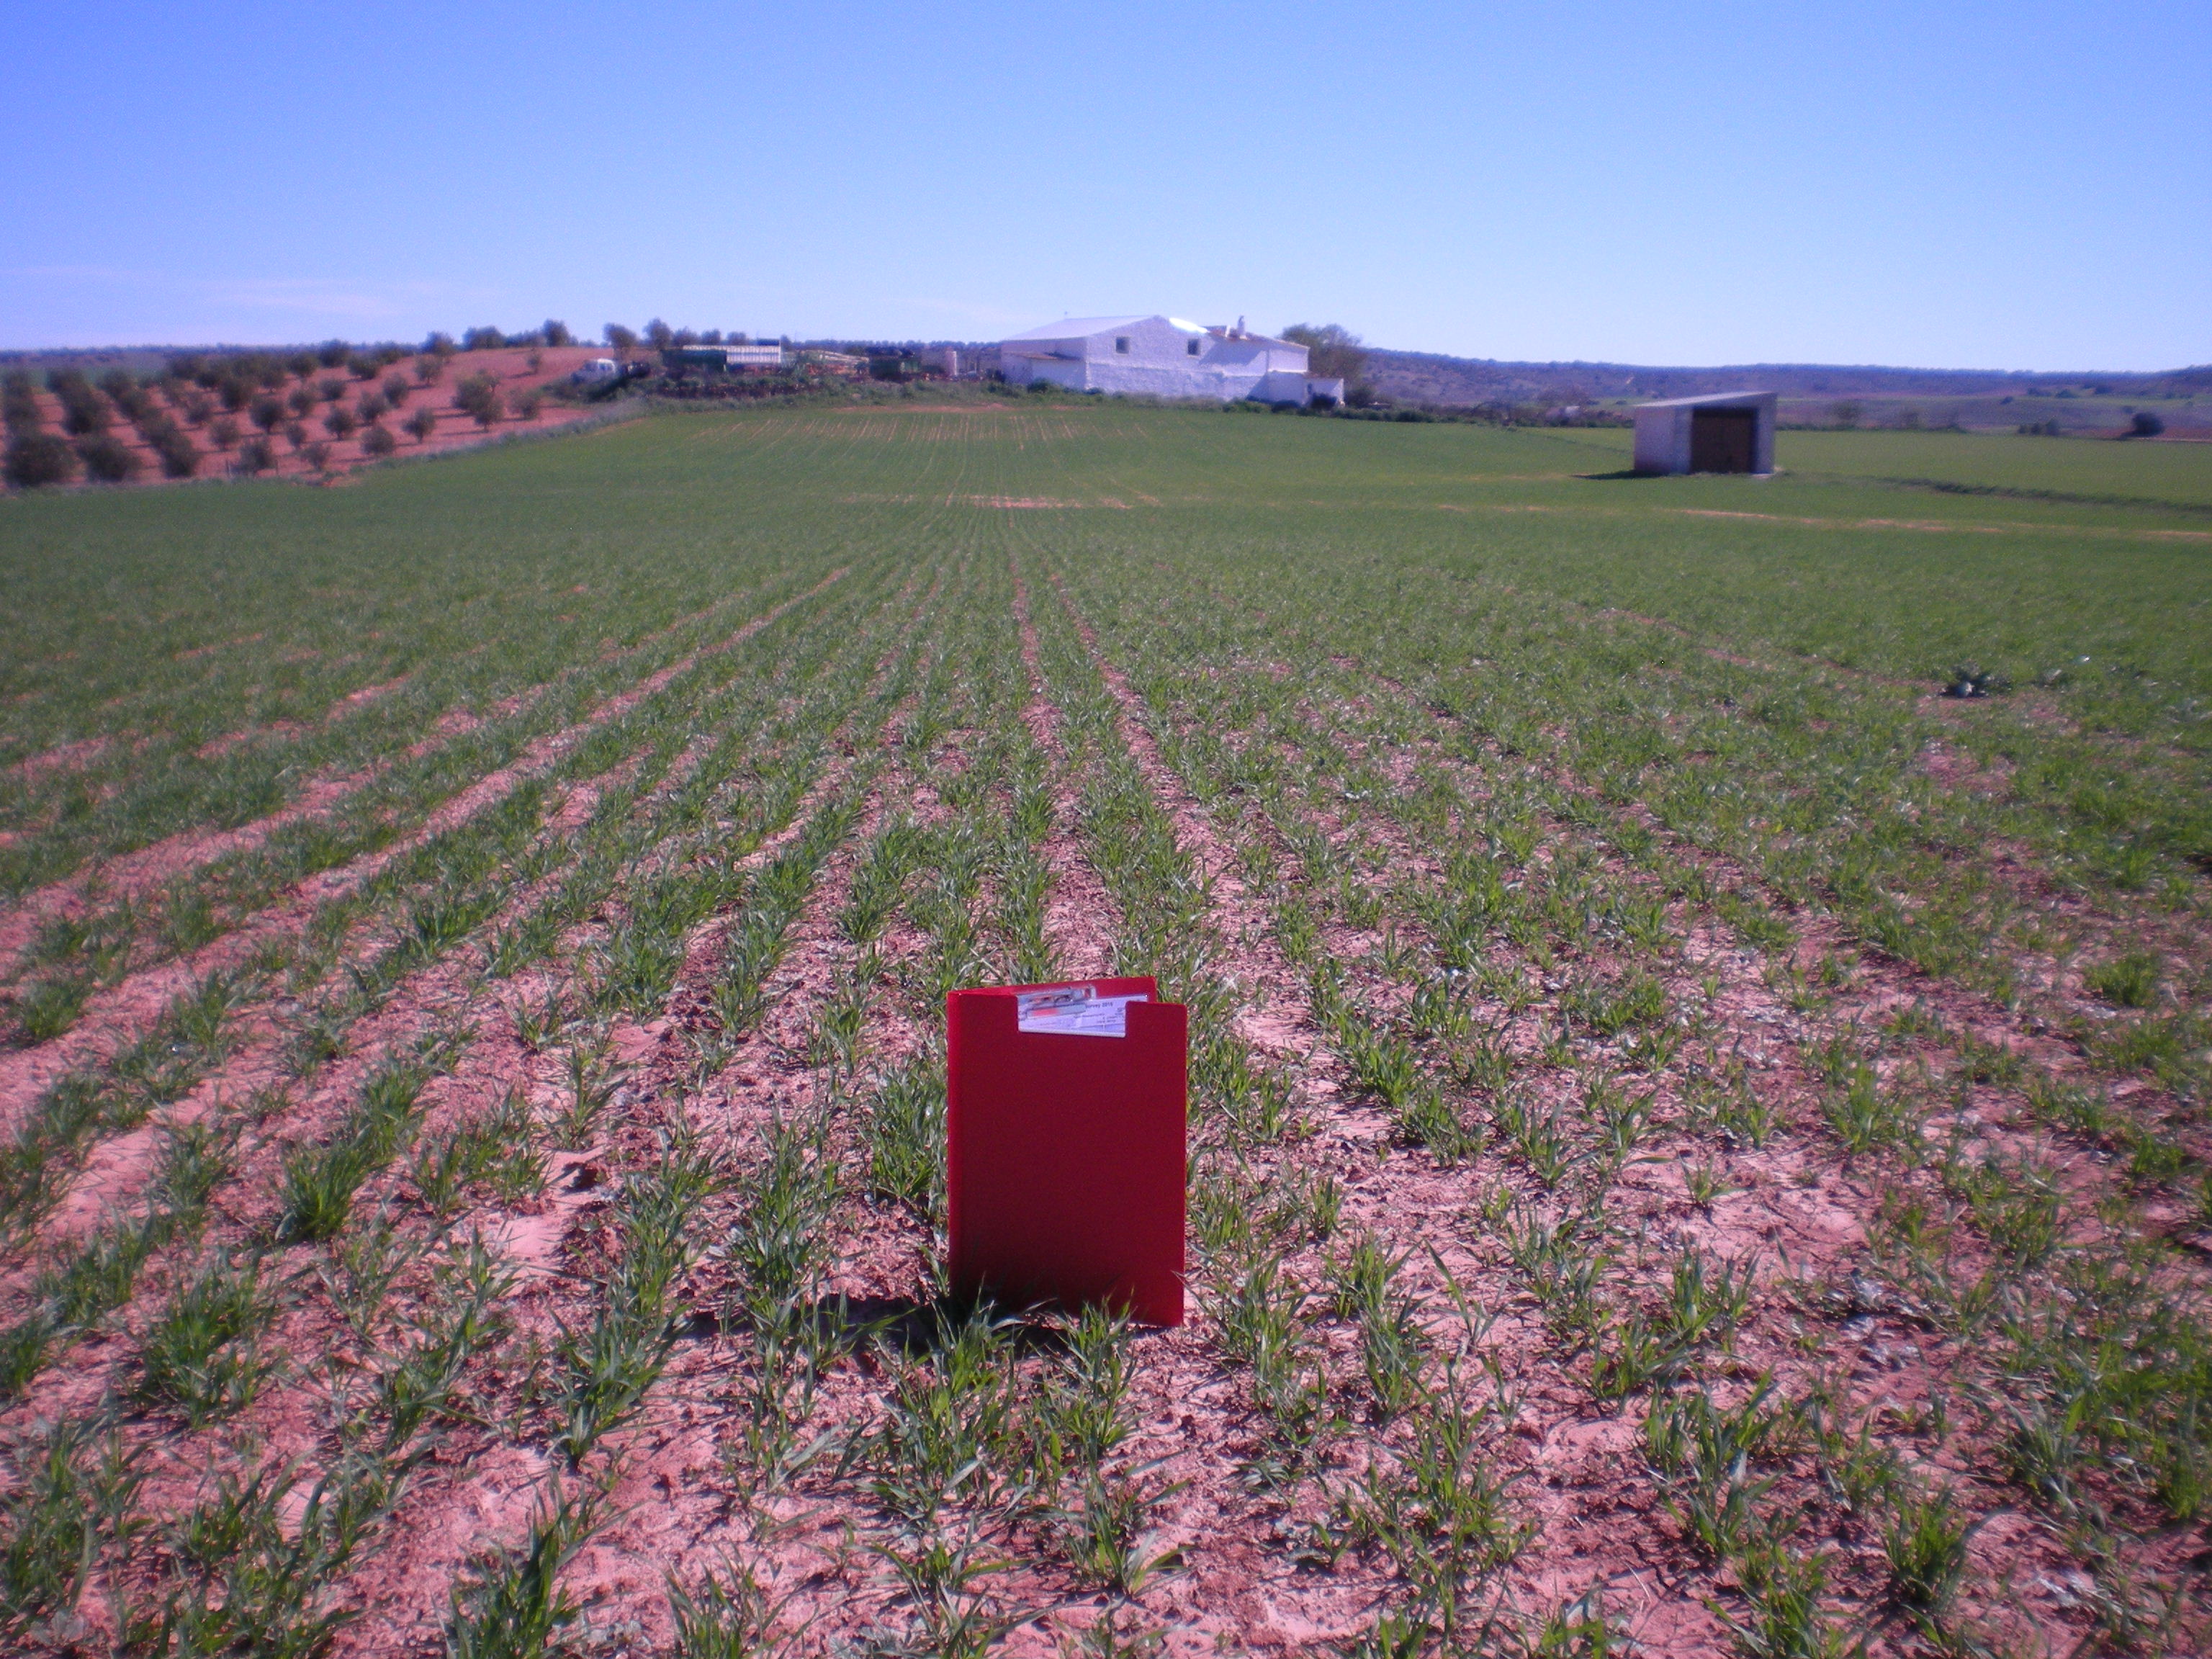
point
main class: Cropland
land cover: Barley
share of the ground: 25 - 50 %
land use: Agriculture (excluding fallow land and kitchen gardens)
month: April
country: ES
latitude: 38.7755
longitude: -3.0025
